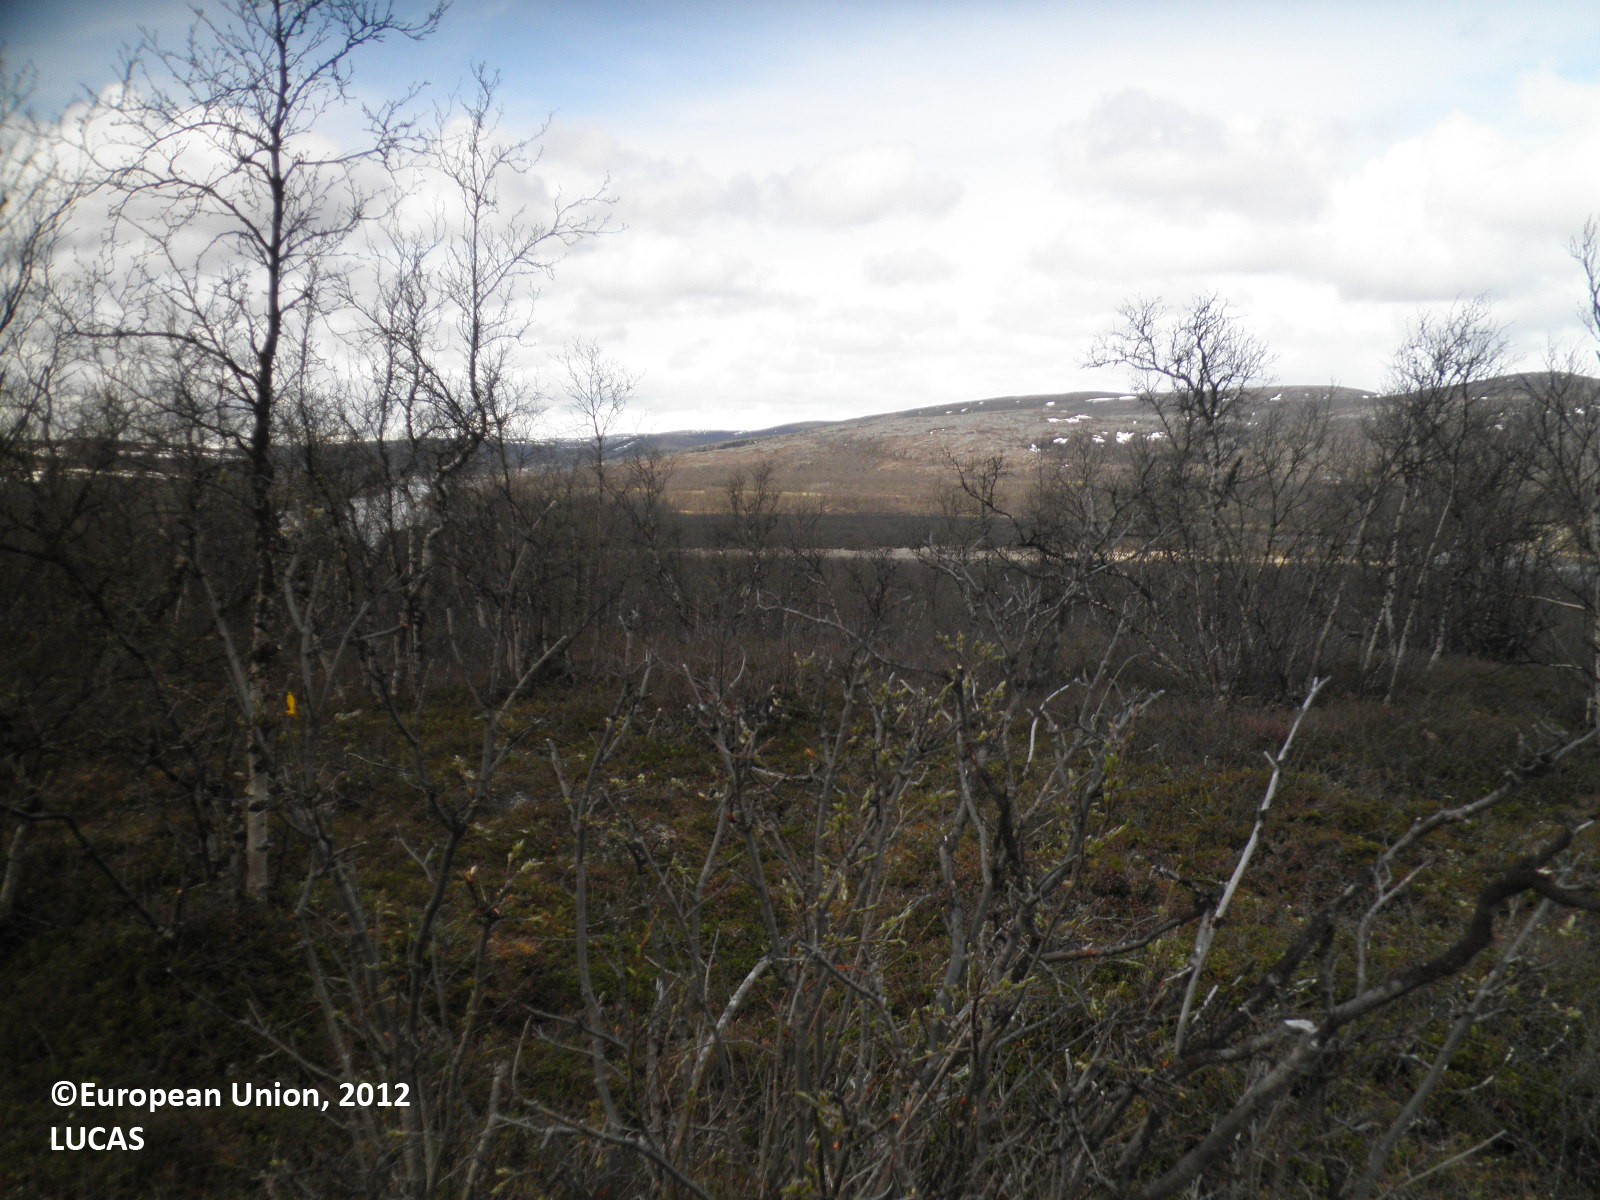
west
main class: Woodland
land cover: Broadleaved woodland
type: boreal forest
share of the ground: 10 - 25 %
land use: Forestry
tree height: < 5 m
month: May
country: FI
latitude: 70.0248
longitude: 27.5466
